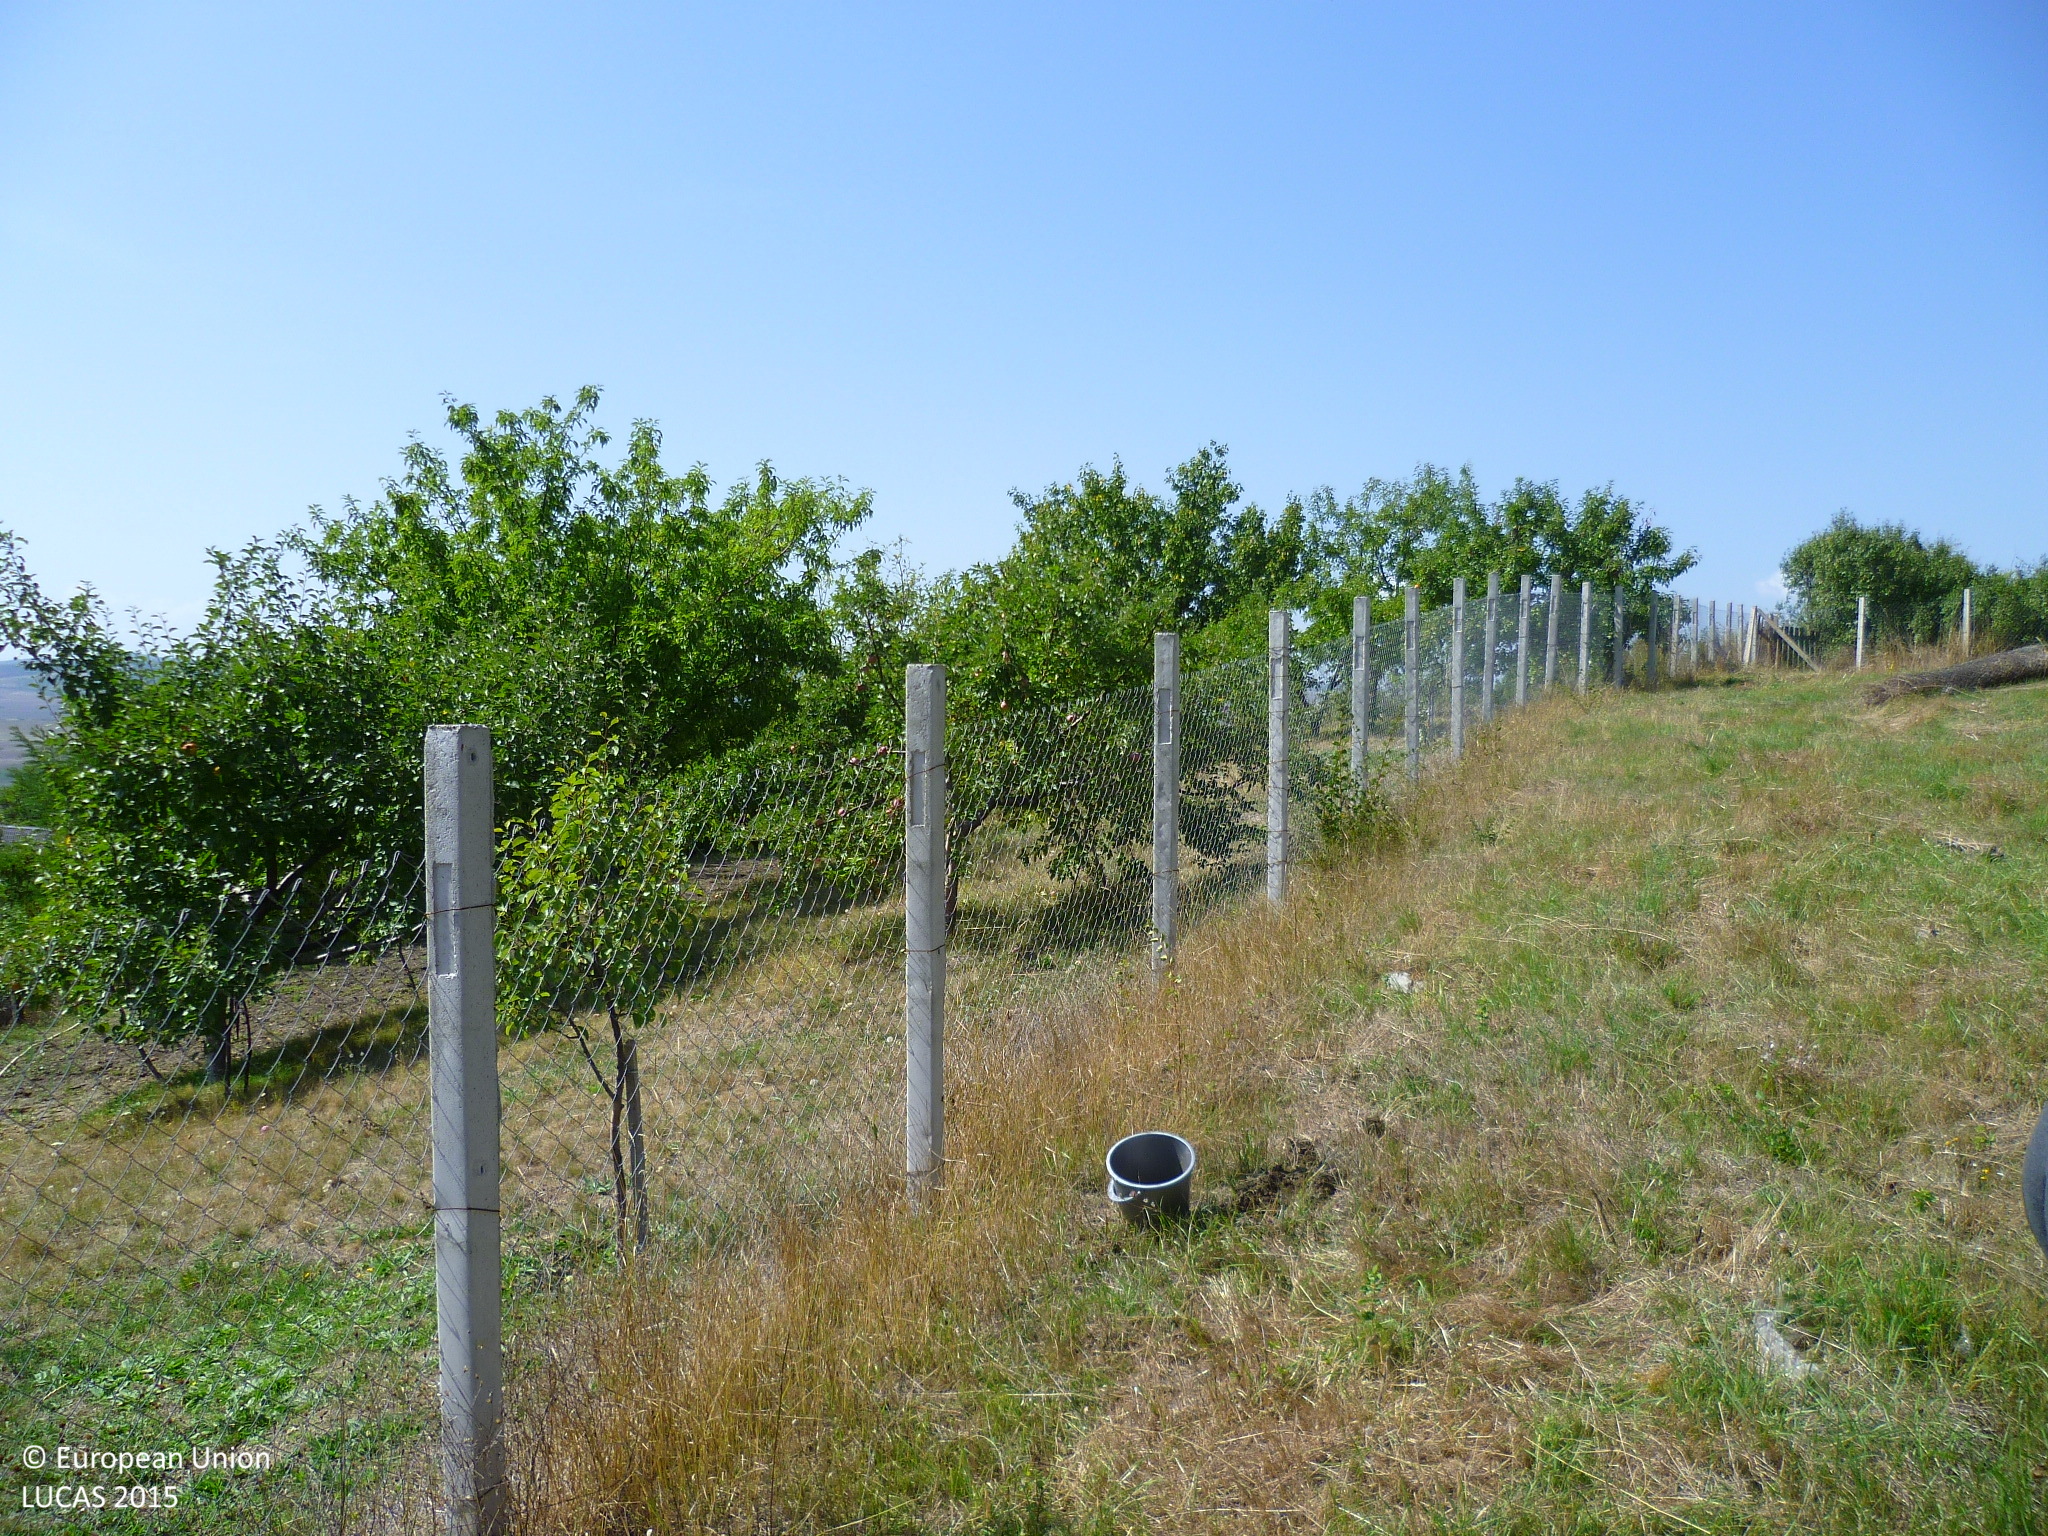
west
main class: Cropland
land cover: Apple fruit
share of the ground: 50 - 75 %
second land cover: Spontaneously vegetated surfaces
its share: 50 - 75 %
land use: Kitchen garden
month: September
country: BG
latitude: 42.6206
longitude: 22.9642
